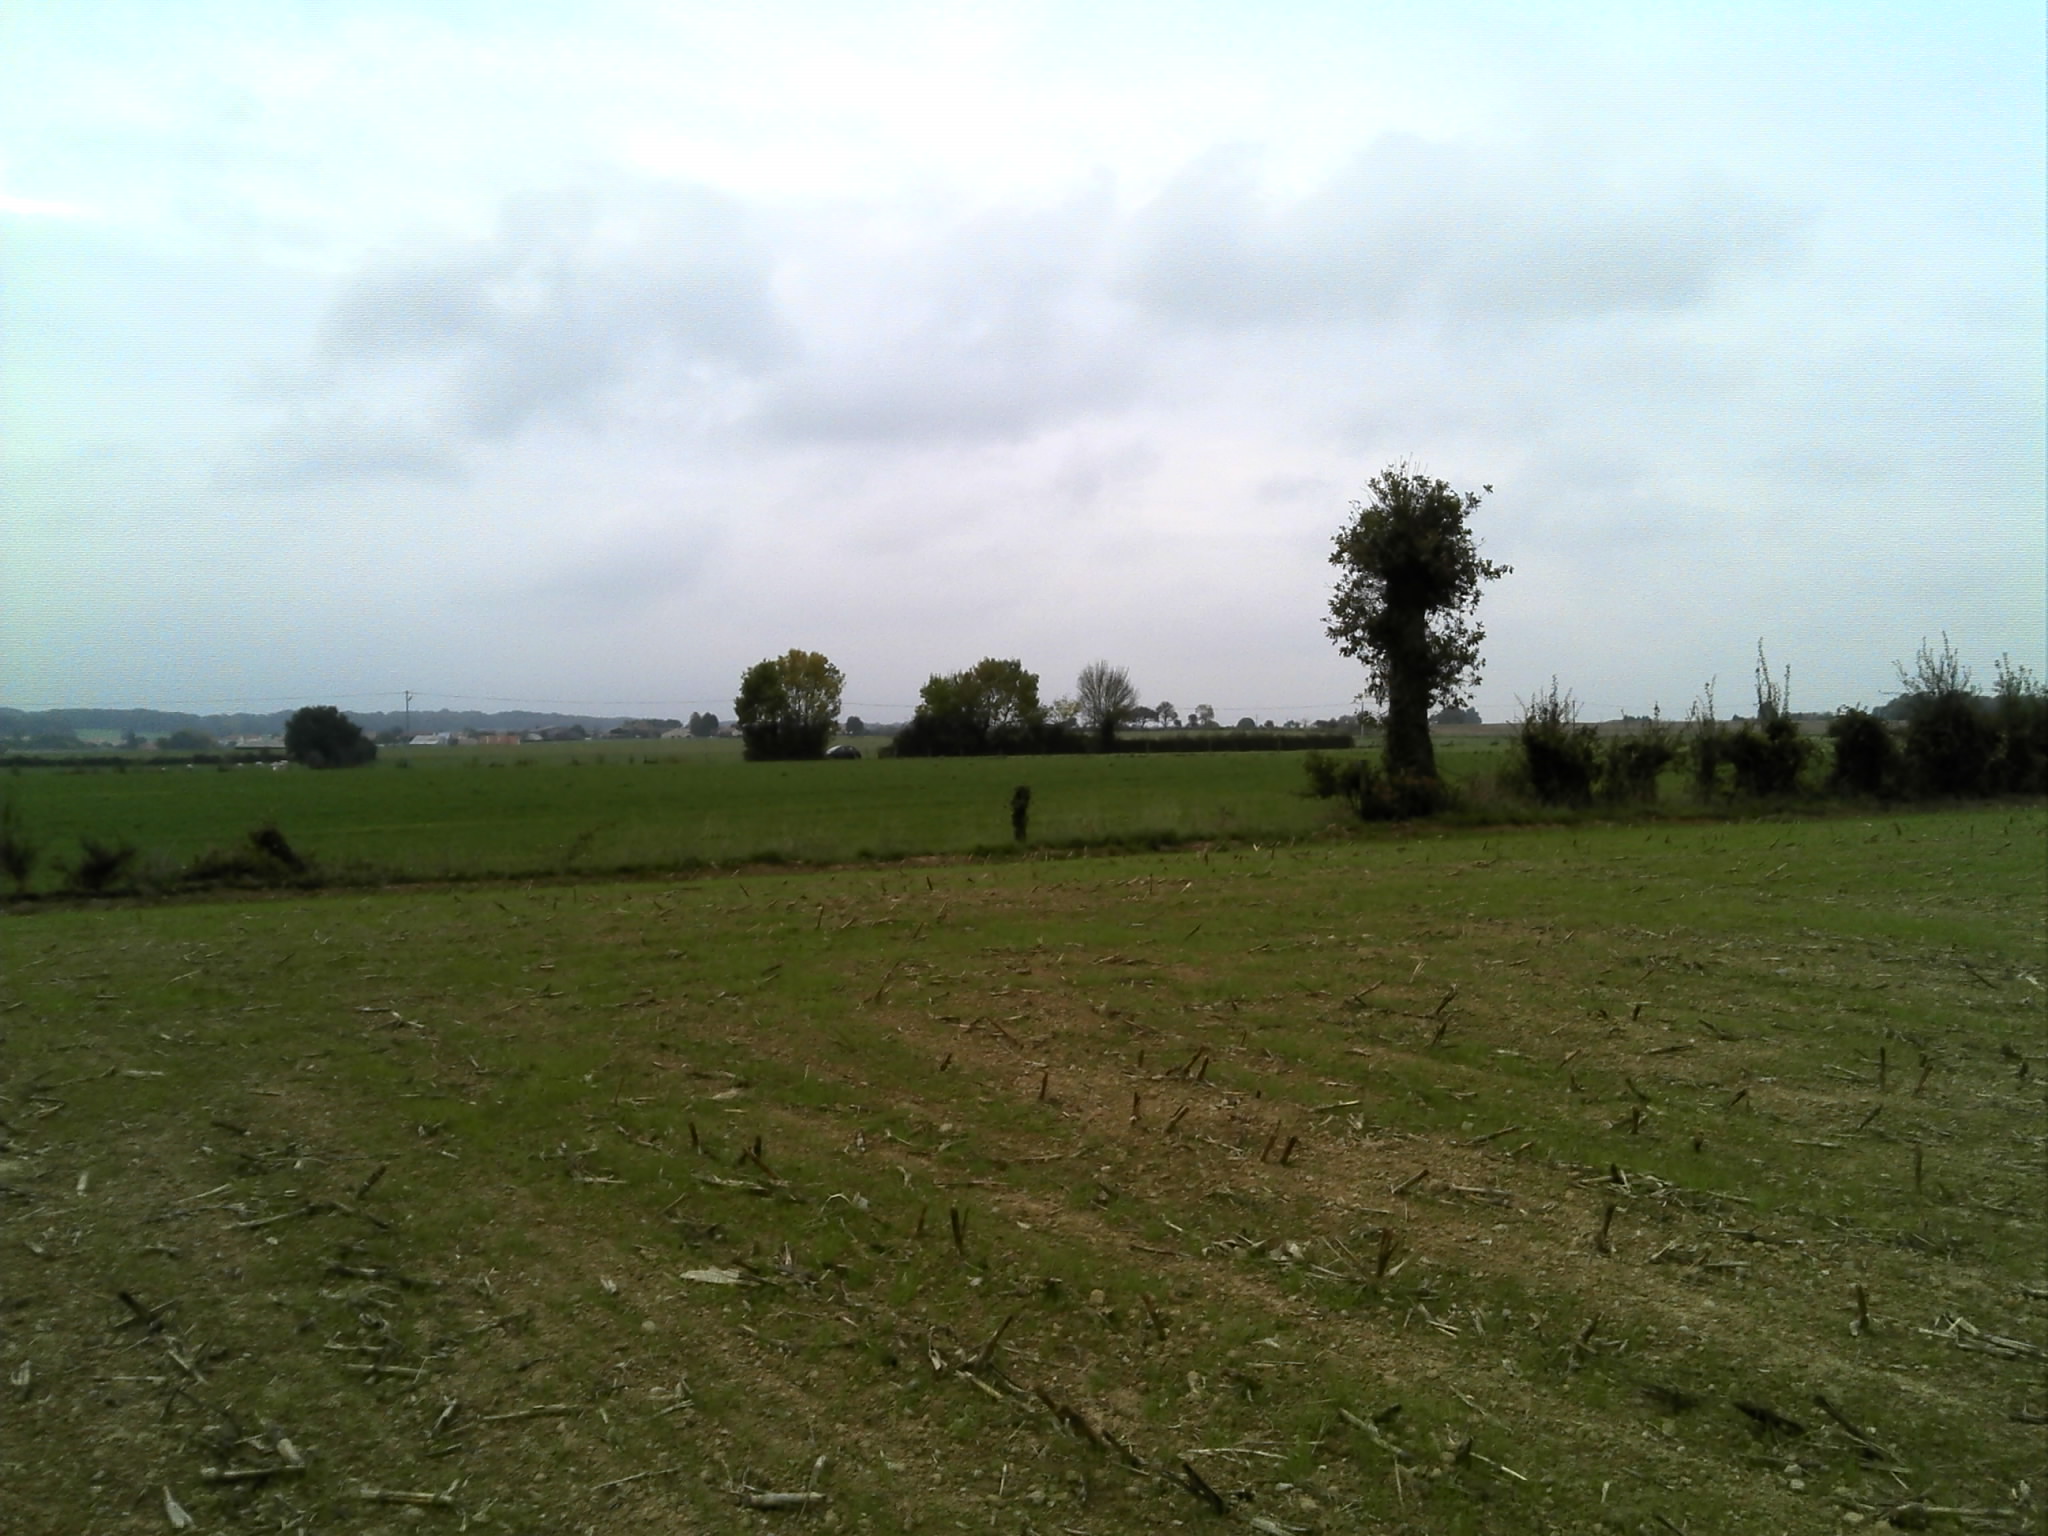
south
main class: Cropland
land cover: Temporary grasslands
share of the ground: 10 - 25 %
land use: Agriculture (excluding fallow land and kitchen gardens)
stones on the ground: 10 - 25 %
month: October
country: FR
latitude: 47.2573
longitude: -0.9636
